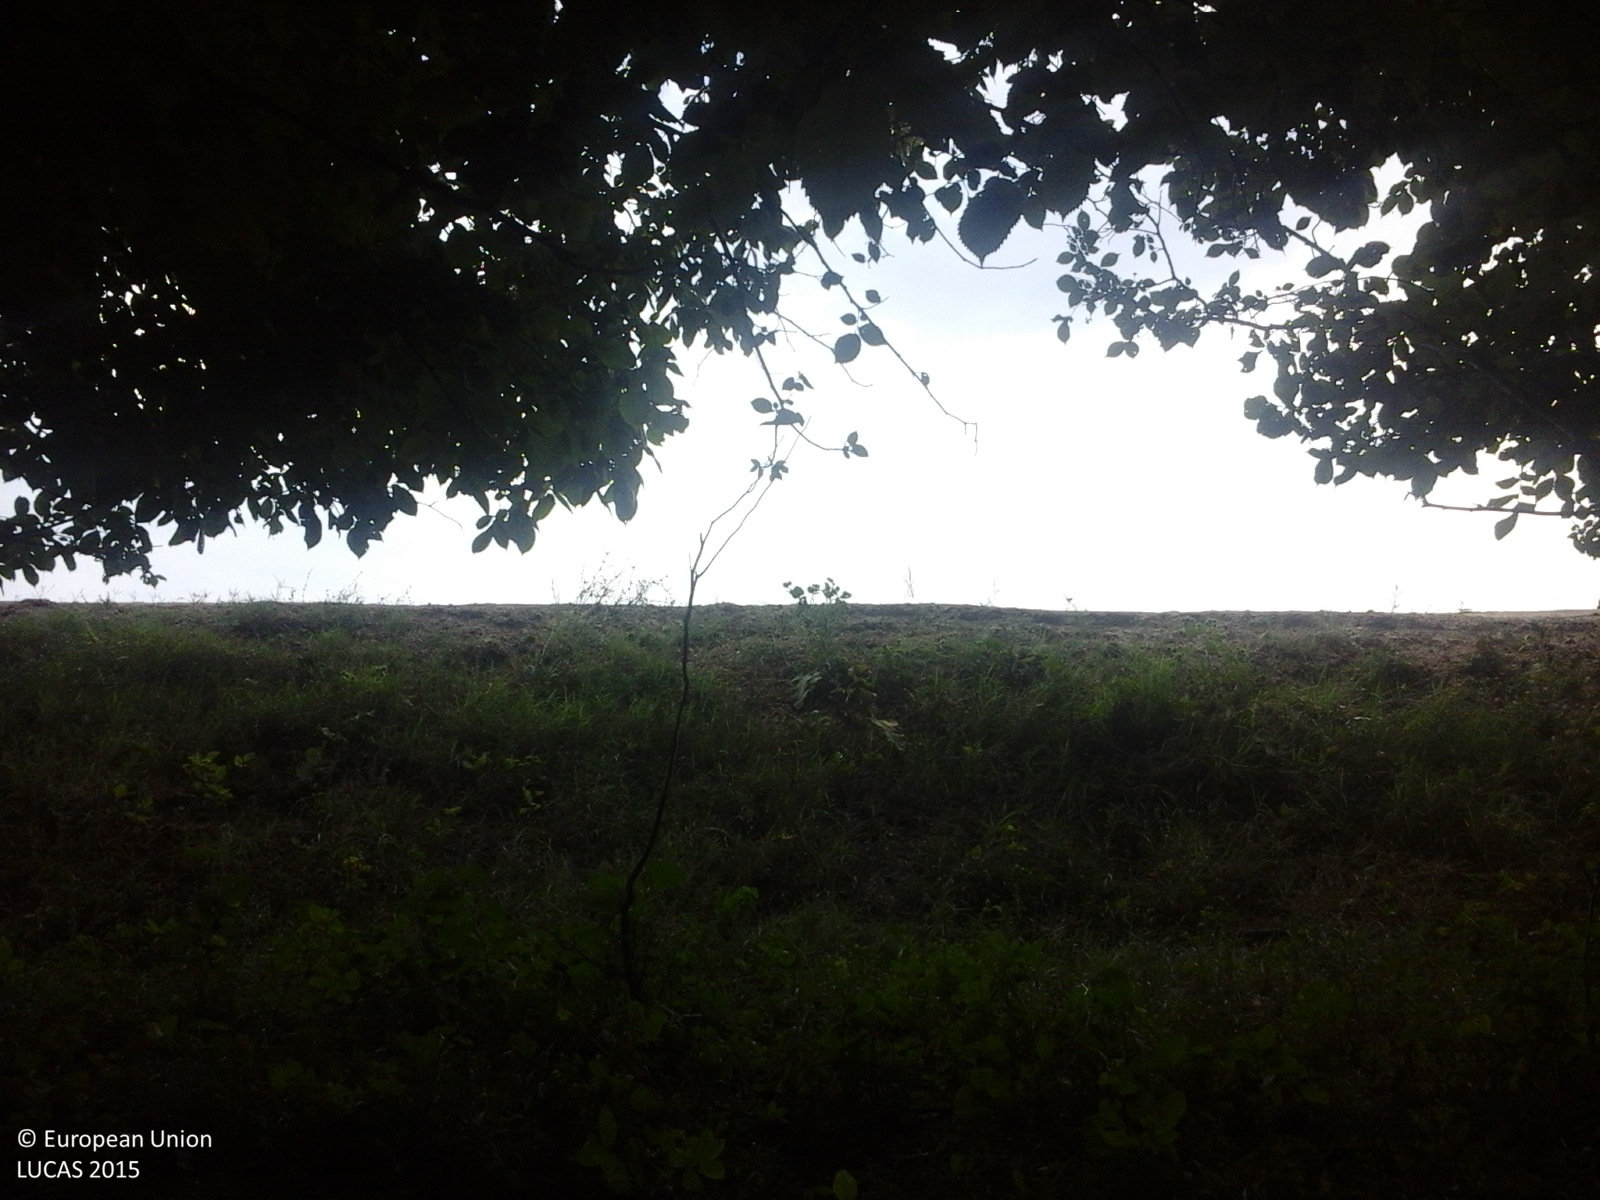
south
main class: Woodland
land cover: Broadleaved woodland
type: floodplain forest
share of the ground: > 75 %
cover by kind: broadleaved forest trees 100 %
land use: Forestry
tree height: > 5 m
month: August
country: RO
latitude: 44.2364
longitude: 27.8933
